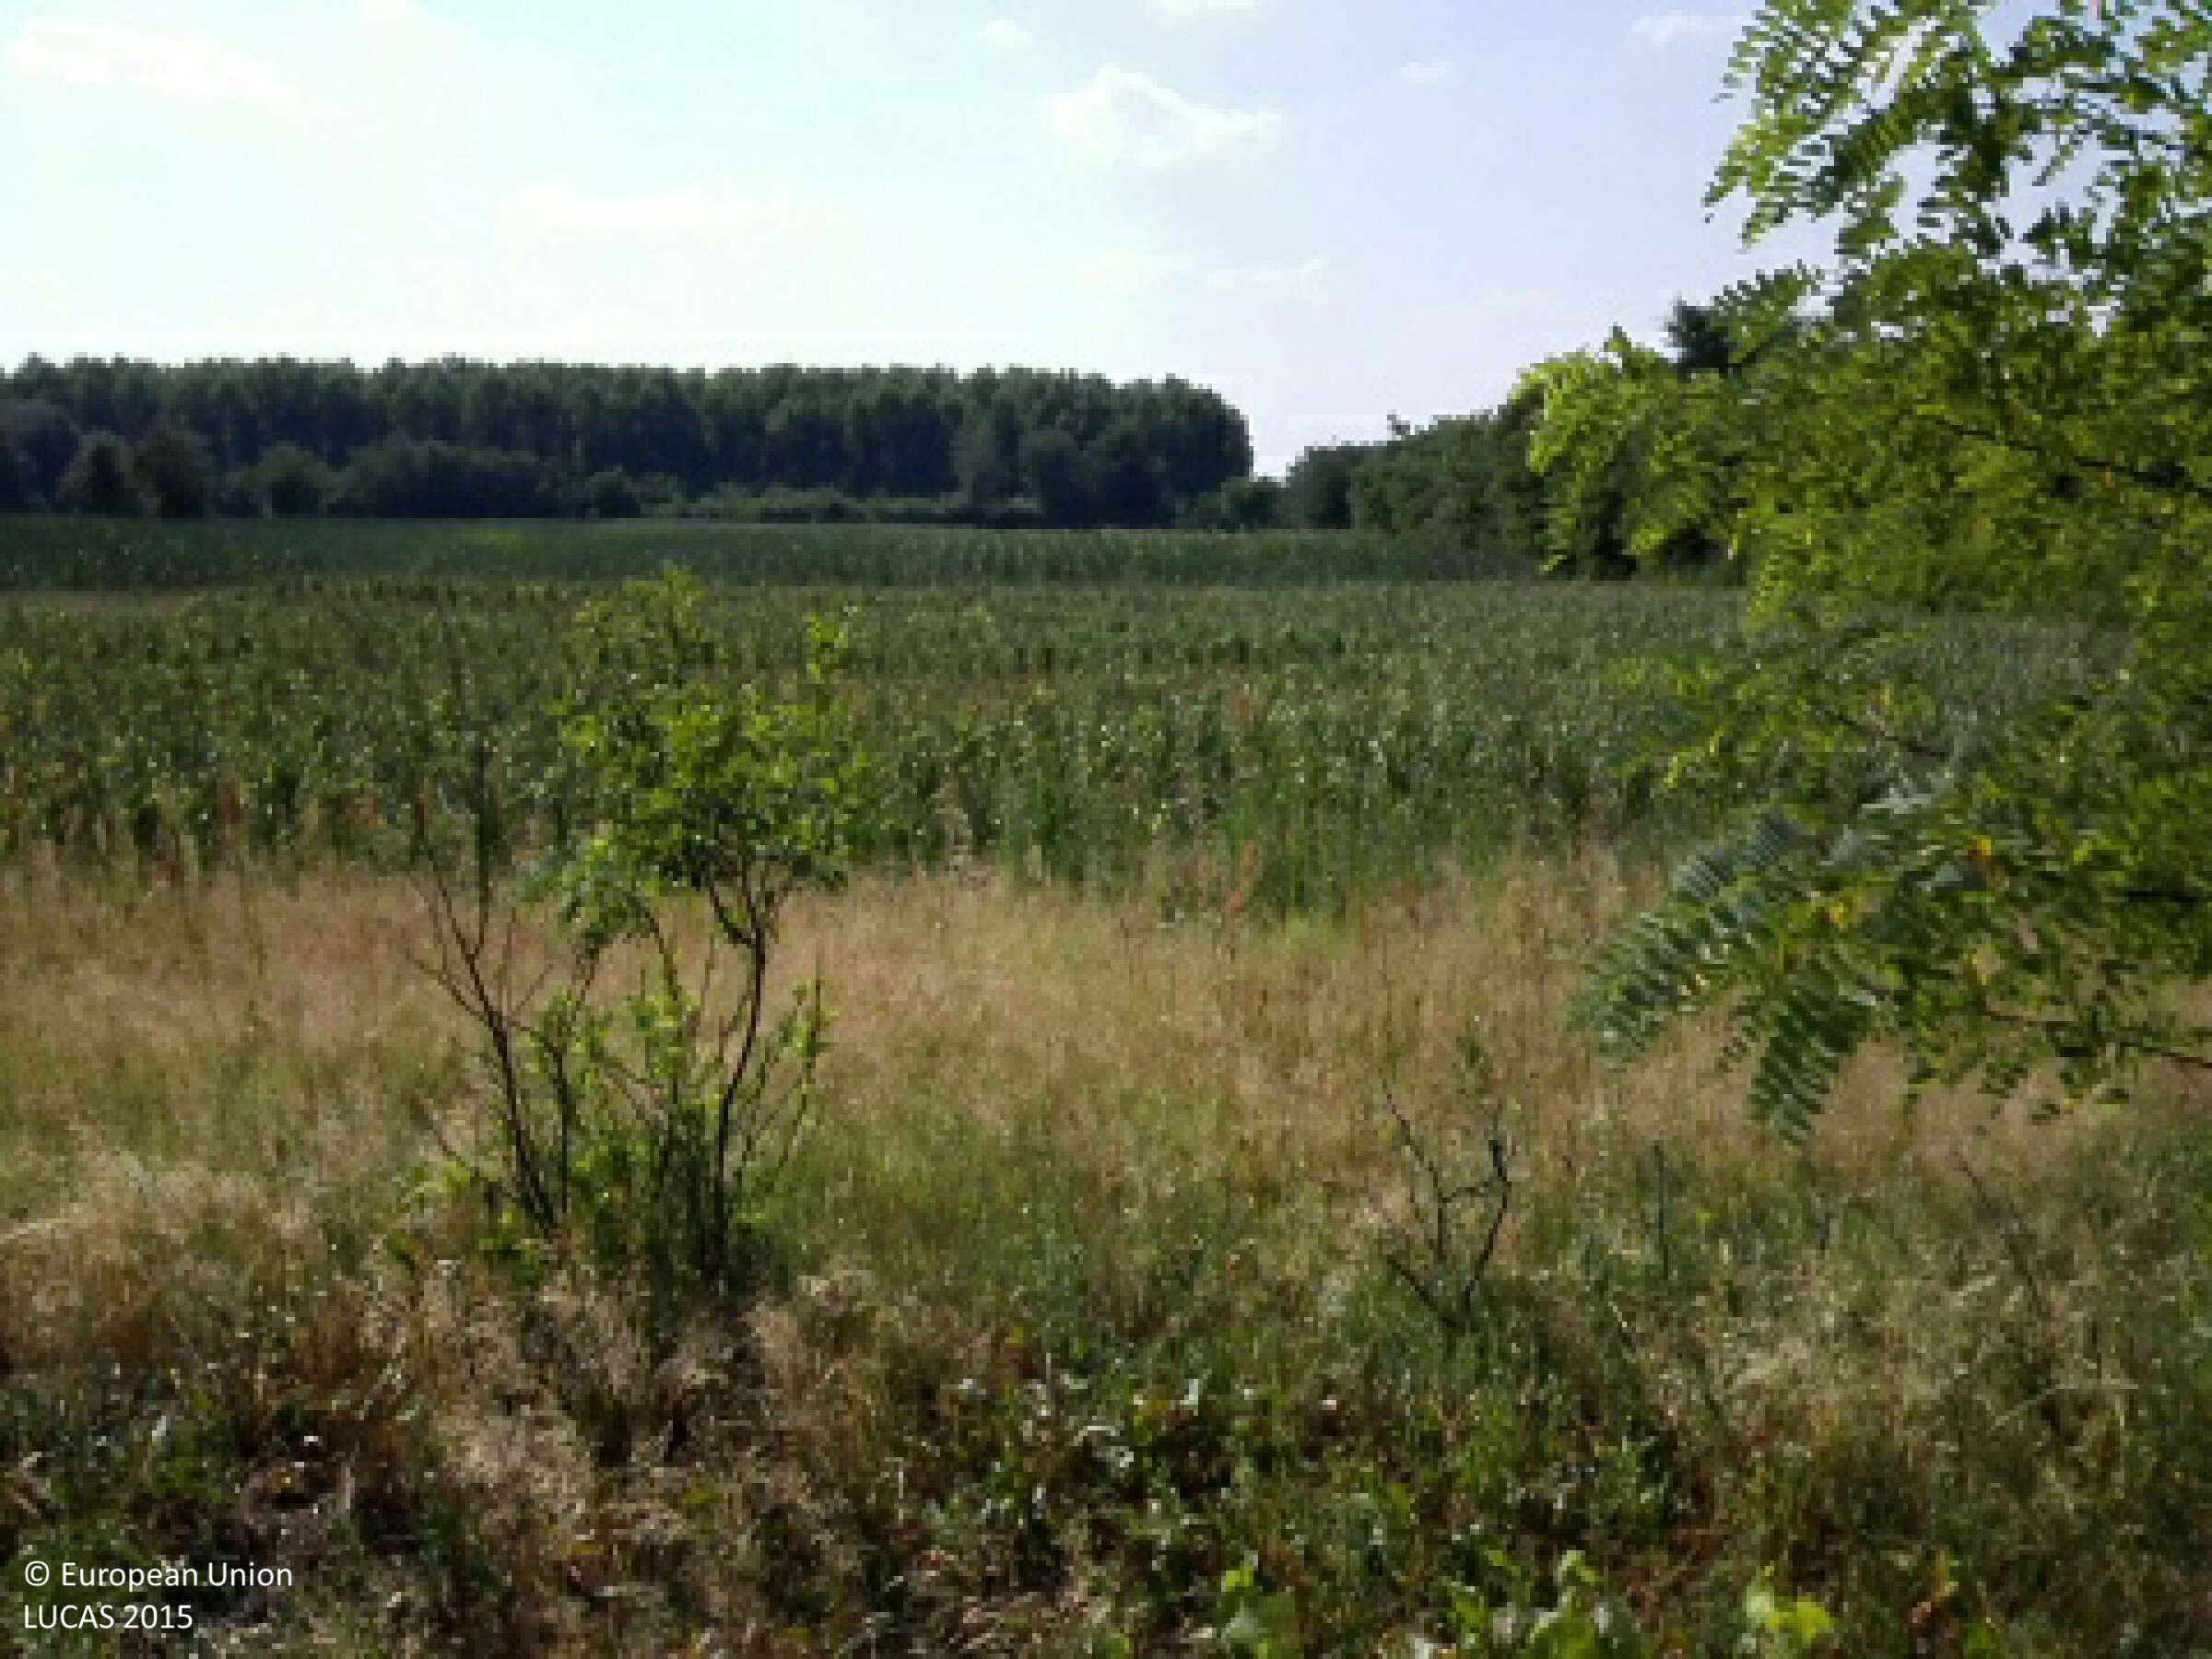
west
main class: Woodland
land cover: Broadleaved woodland
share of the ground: > 75 %
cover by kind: broadleaved forest trees 40 %, shrubs 30 %, herbaceous plants 30 %
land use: Semi-natural and natural areas not in use
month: July
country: HU
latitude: 47.6943
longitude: 21.6512
